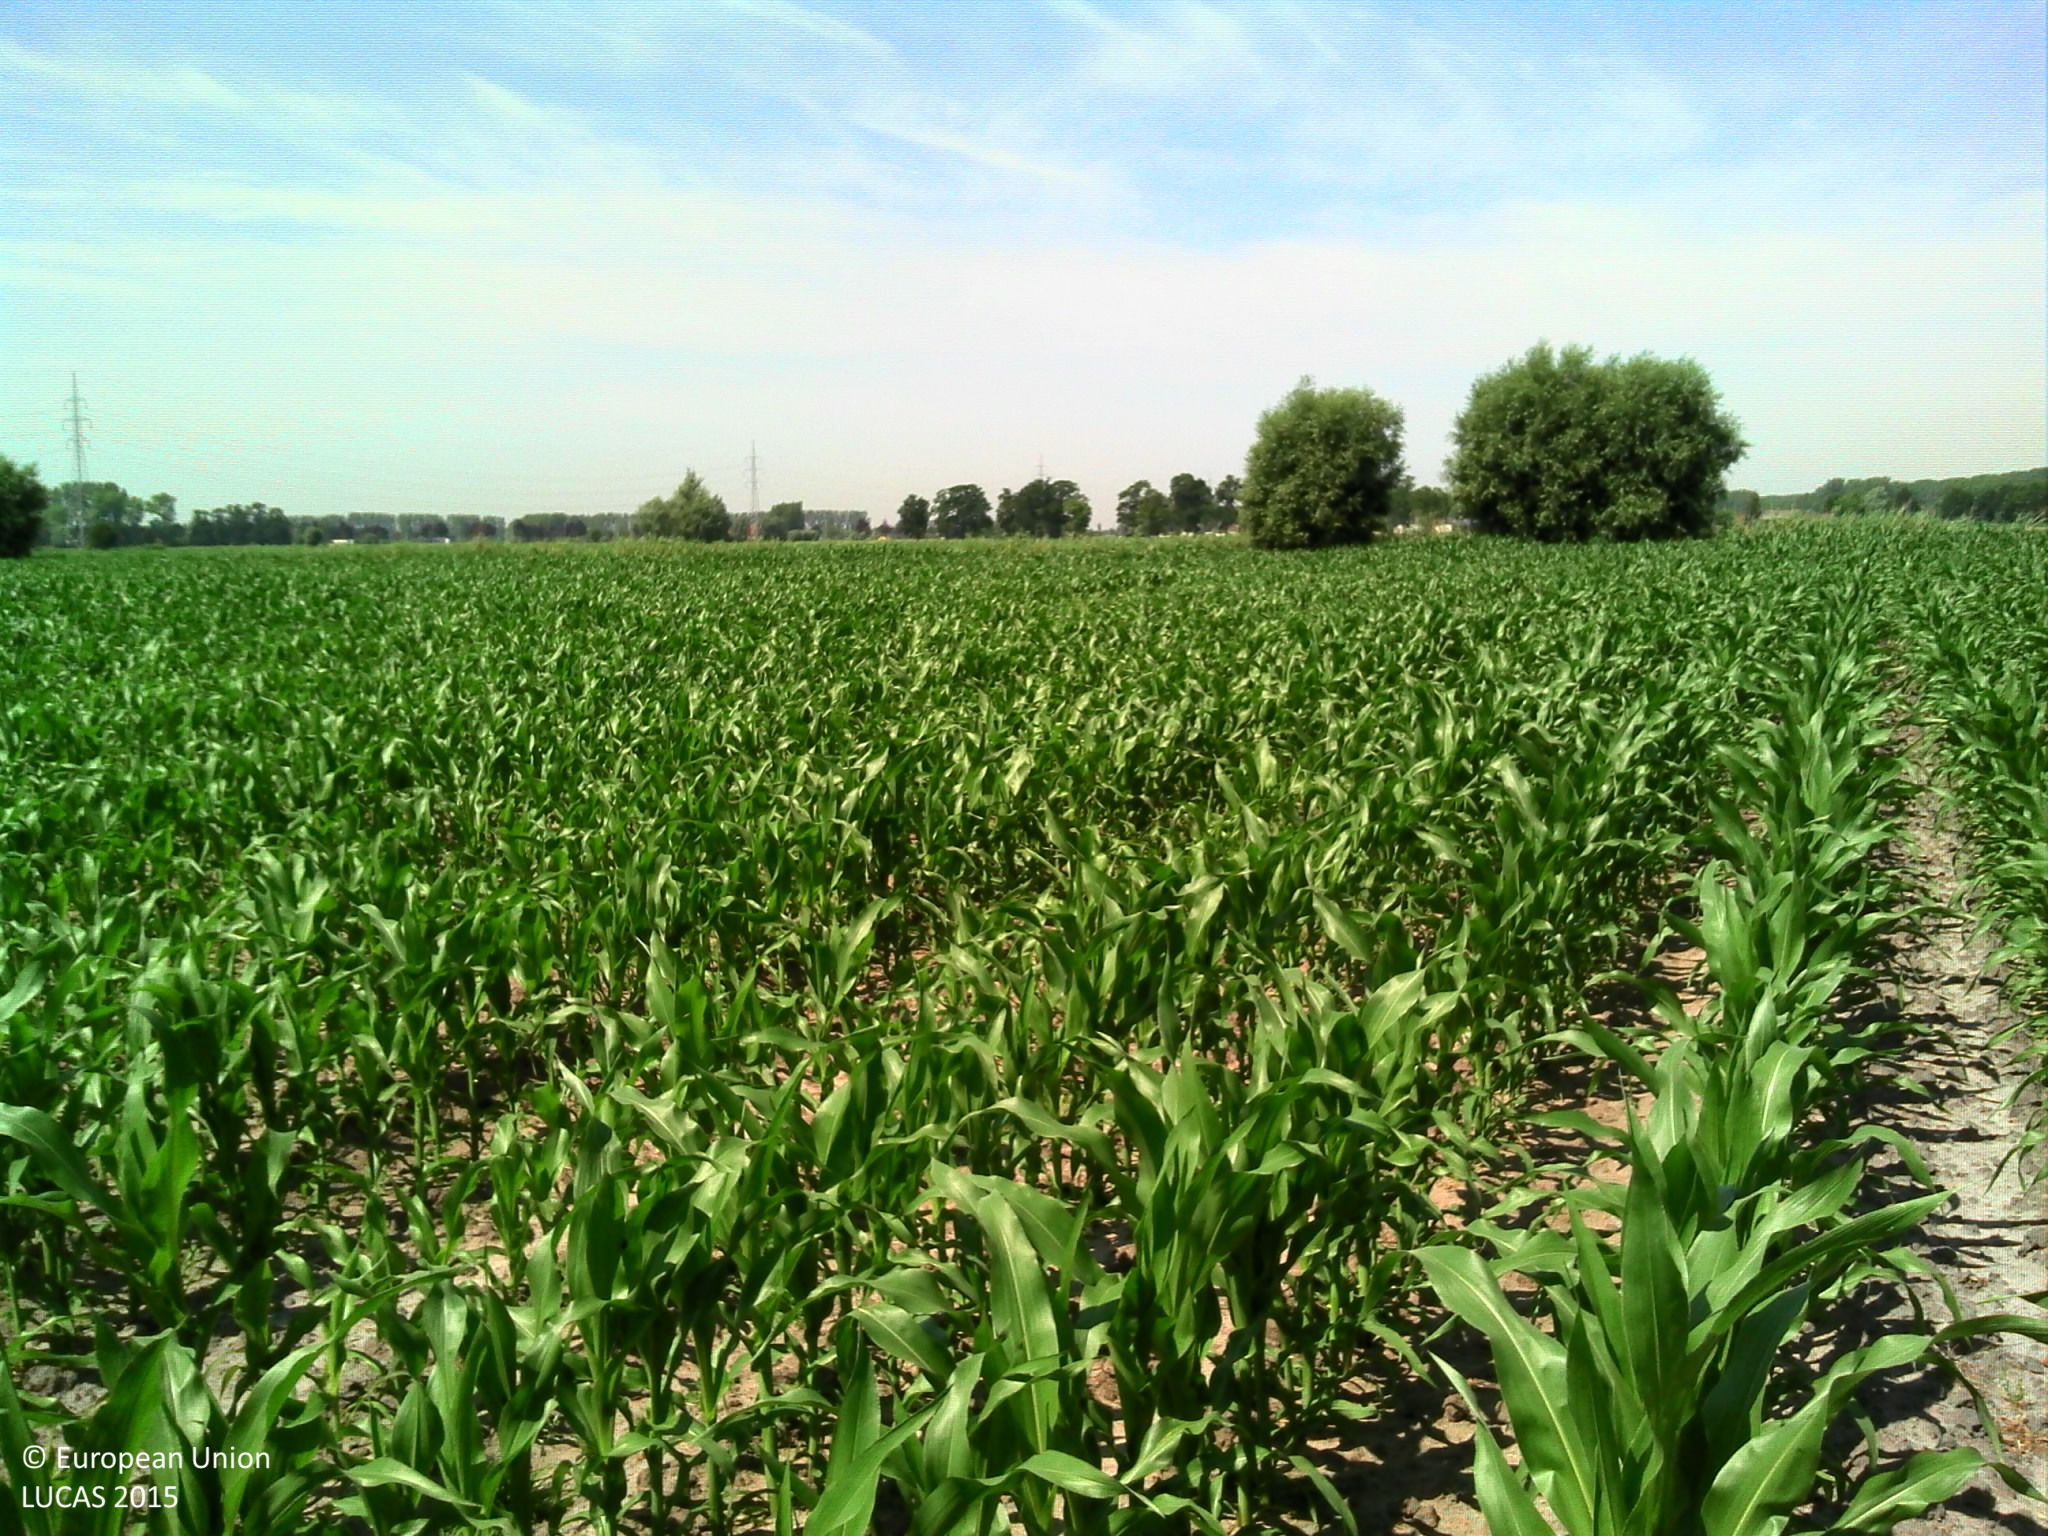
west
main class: Cropland
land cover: Maize
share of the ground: > 75 %
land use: Agriculture (excluding fallow land and kitchen gardens)
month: July
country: BE
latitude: 51.2388
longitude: 3.4173
